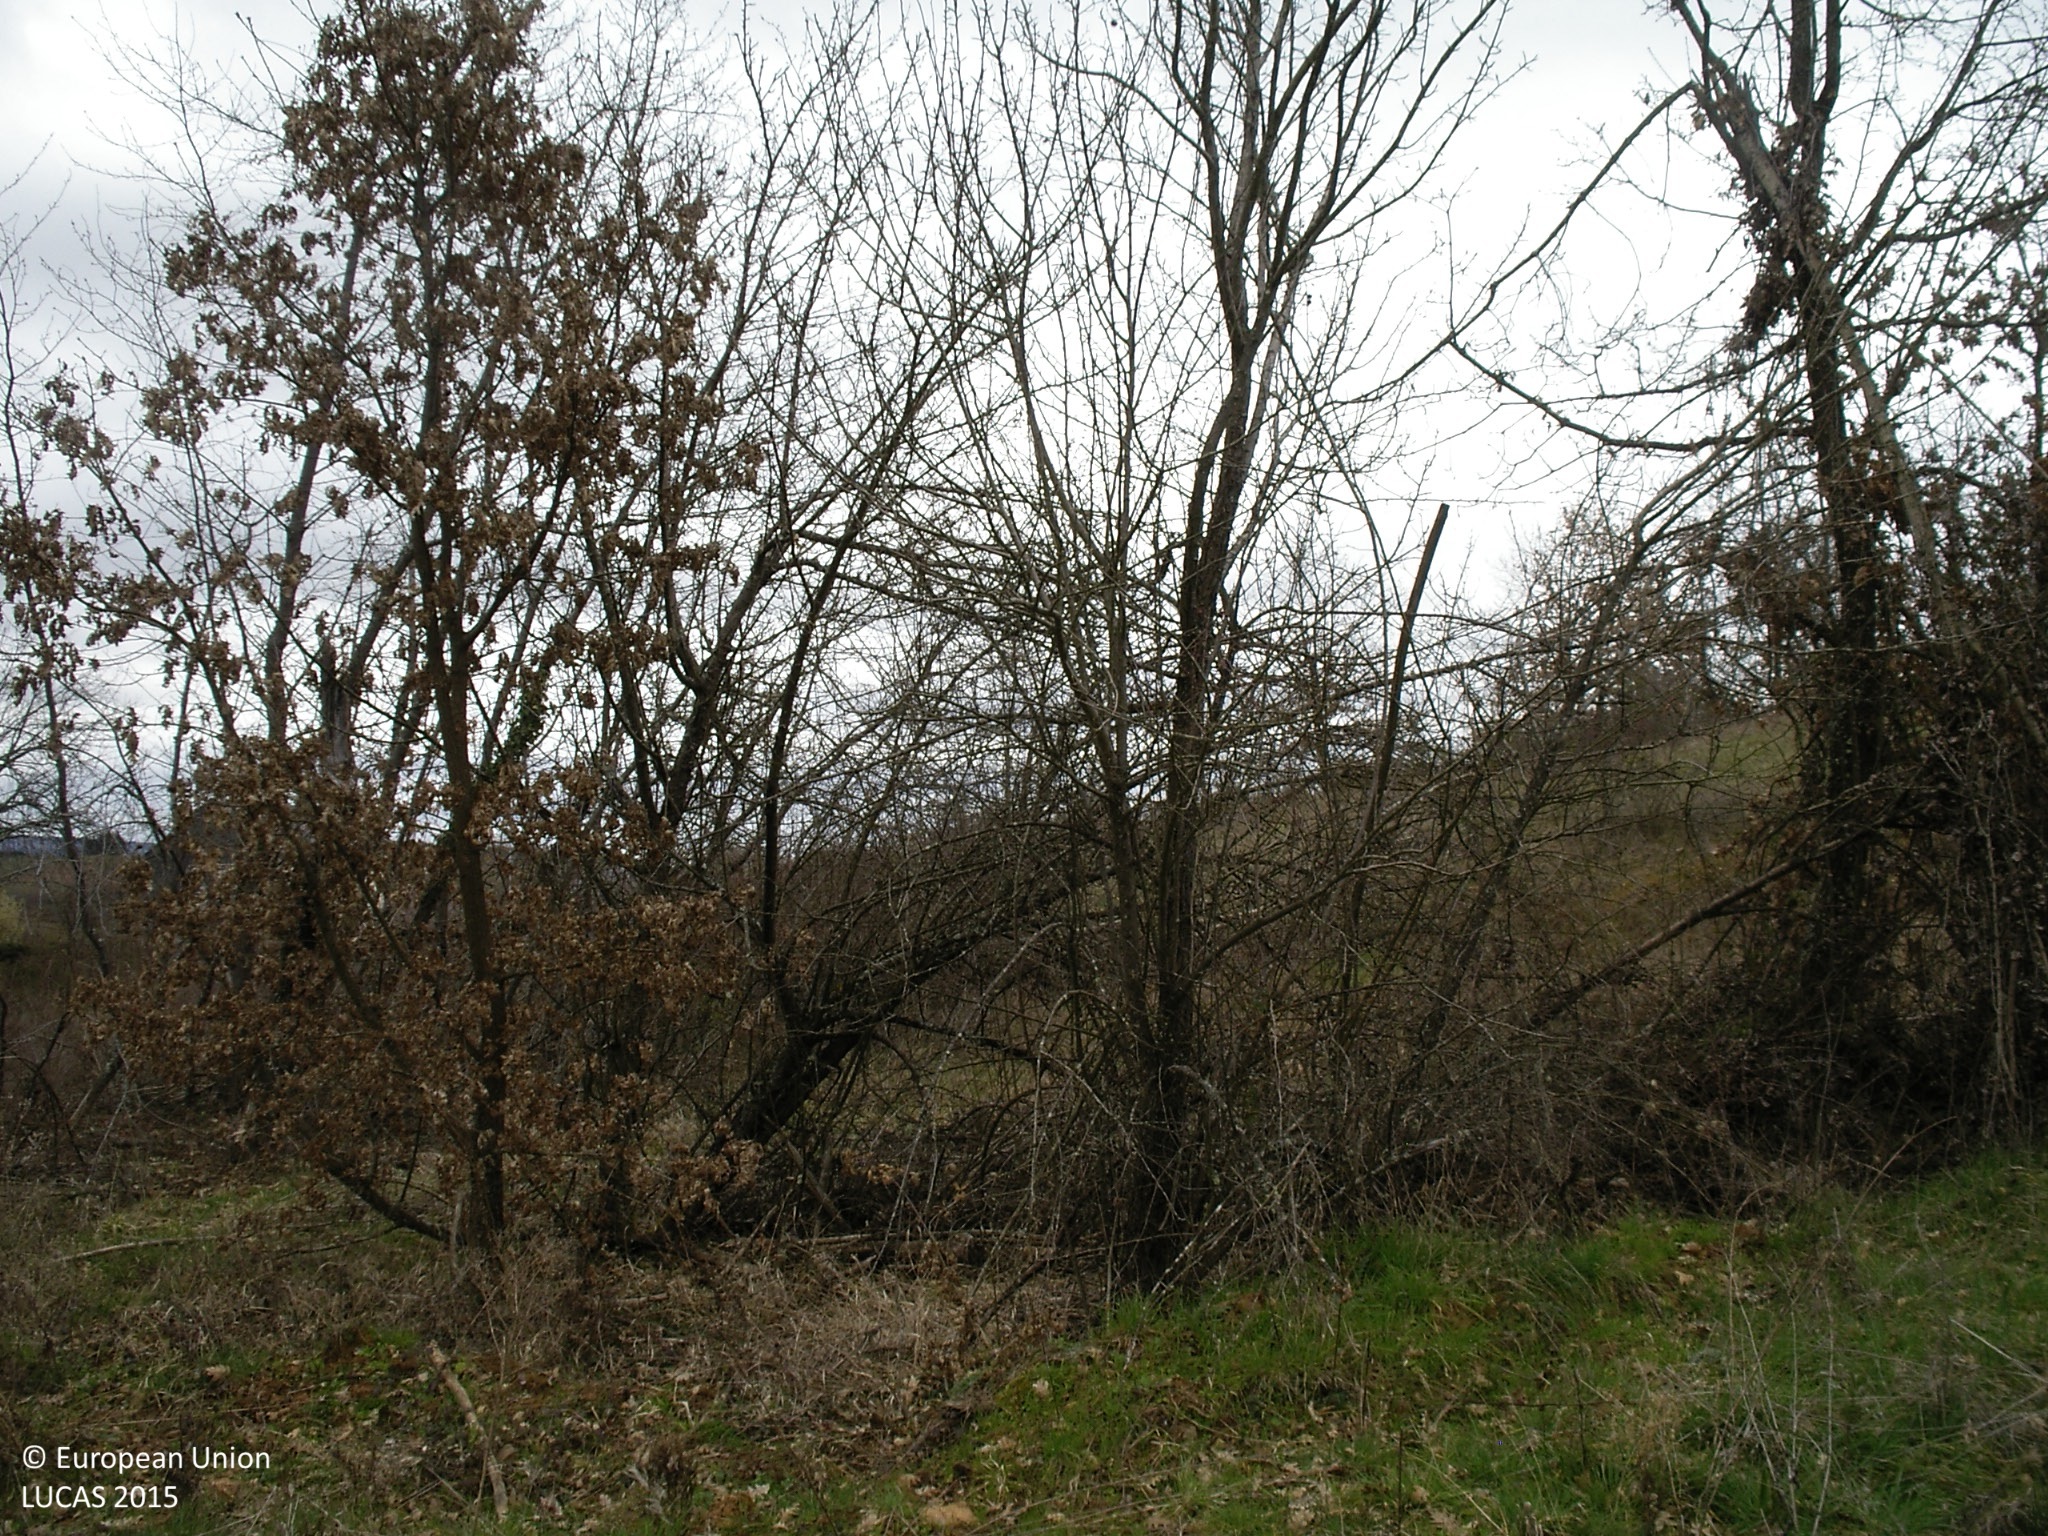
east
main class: Woodland
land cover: Broadleaved woodland
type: thermophilous deciduous forest
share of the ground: 25 - 50 %
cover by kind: herbaceous plants 55 %, broadleaved forest trees 30 %, shrubs 15 %
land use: Forestry
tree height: > 5 m
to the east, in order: Broadleaved woodland; Shrubland without tree cover; Shrubland with sparse tree cover; Artificial constructions; Paved roads, cycling and walking lanes; Artificial constructions; Managed hedges; Fences; Grassland without tree/shrub cover; Artificial constructions in urban areas; Shrubland with sparse tree cover; Grassland with sparse tree/shrub cover; Paved roads, cycling and walking lanes; Dry stone walls; Electric lines; Grassland with sparse tree/shrub cover; Dry stone walls; Grassland with sparse tree/shrub cover; Apple fruit; Ditches and canals; Grassland without tree/shrub cover
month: March
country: ES
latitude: 42.6411
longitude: -6.4477
